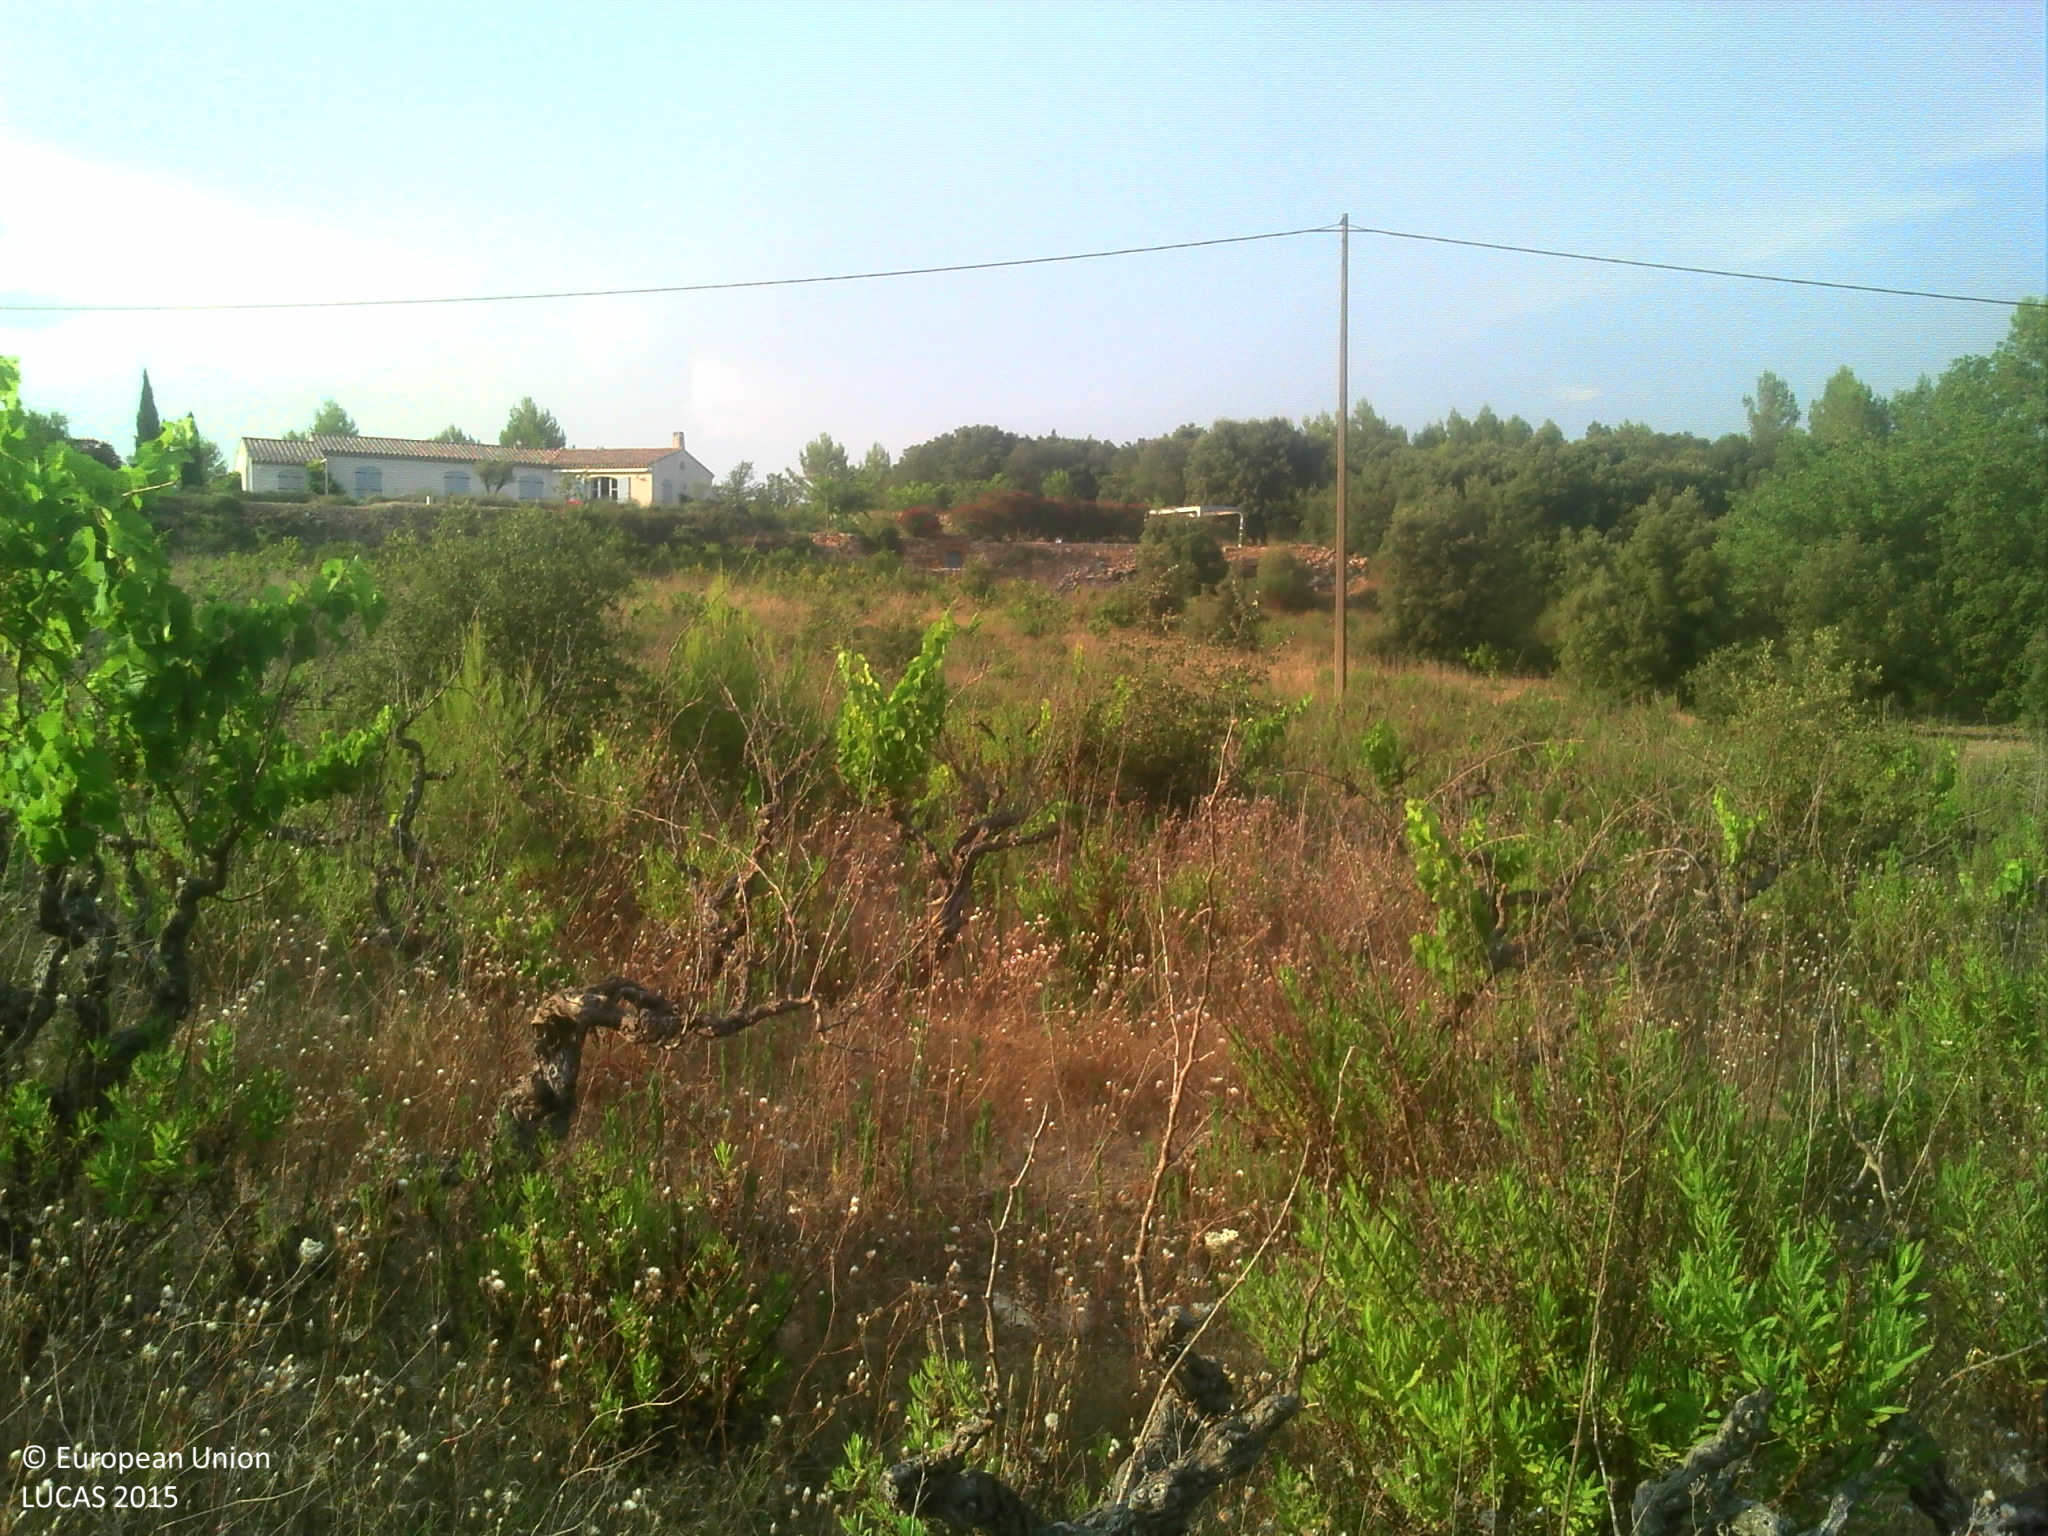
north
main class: Cropland
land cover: Vineyards
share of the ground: 25 - 50 %
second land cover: Grassland without tree/shrub cover
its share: > 75 %
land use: Abandoned areas
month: July
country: FR
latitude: 43.4192
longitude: 6.3407
